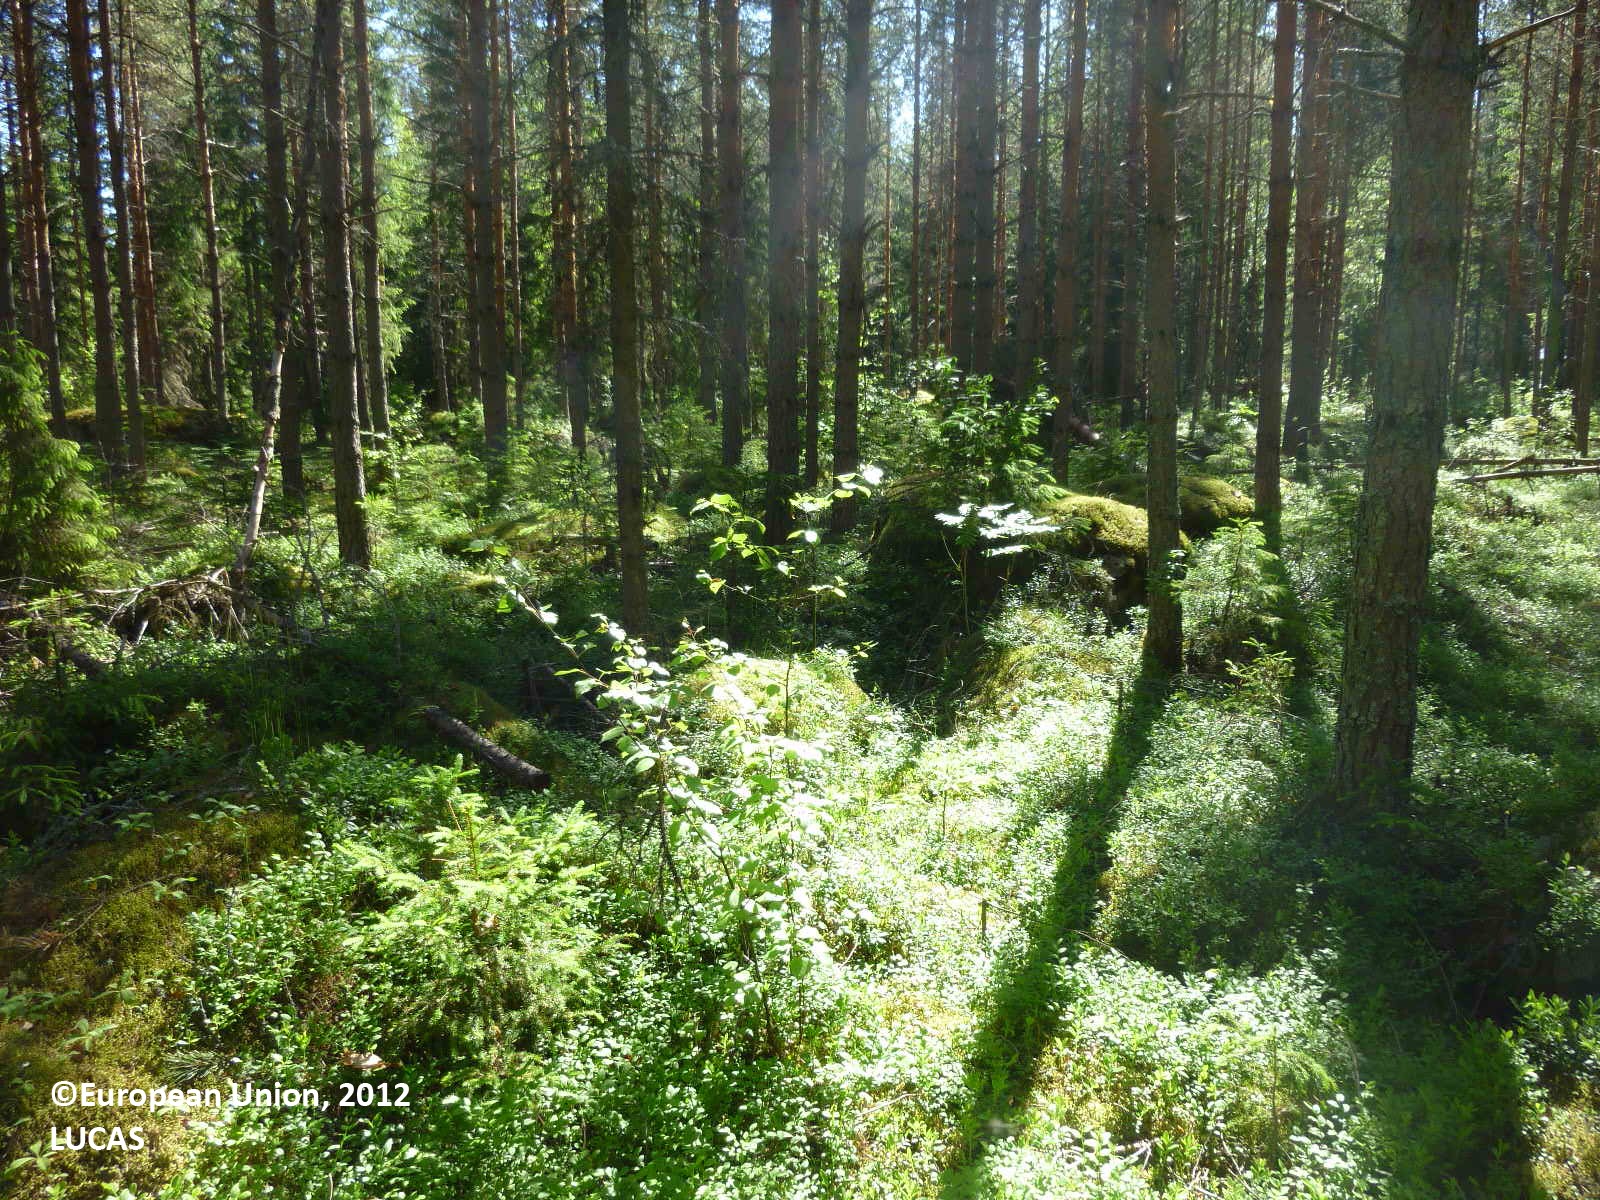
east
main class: Woodland
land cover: Pine dominated coniferous woodland
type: boreal forest
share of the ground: 50 - 75 %
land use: Forestry
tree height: > 5 m
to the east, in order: Pine dominated coniferous woodland; Spruce dominated mixed woodland; Other bare soil
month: June
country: FI
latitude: 61.6250
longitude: 22.1485
